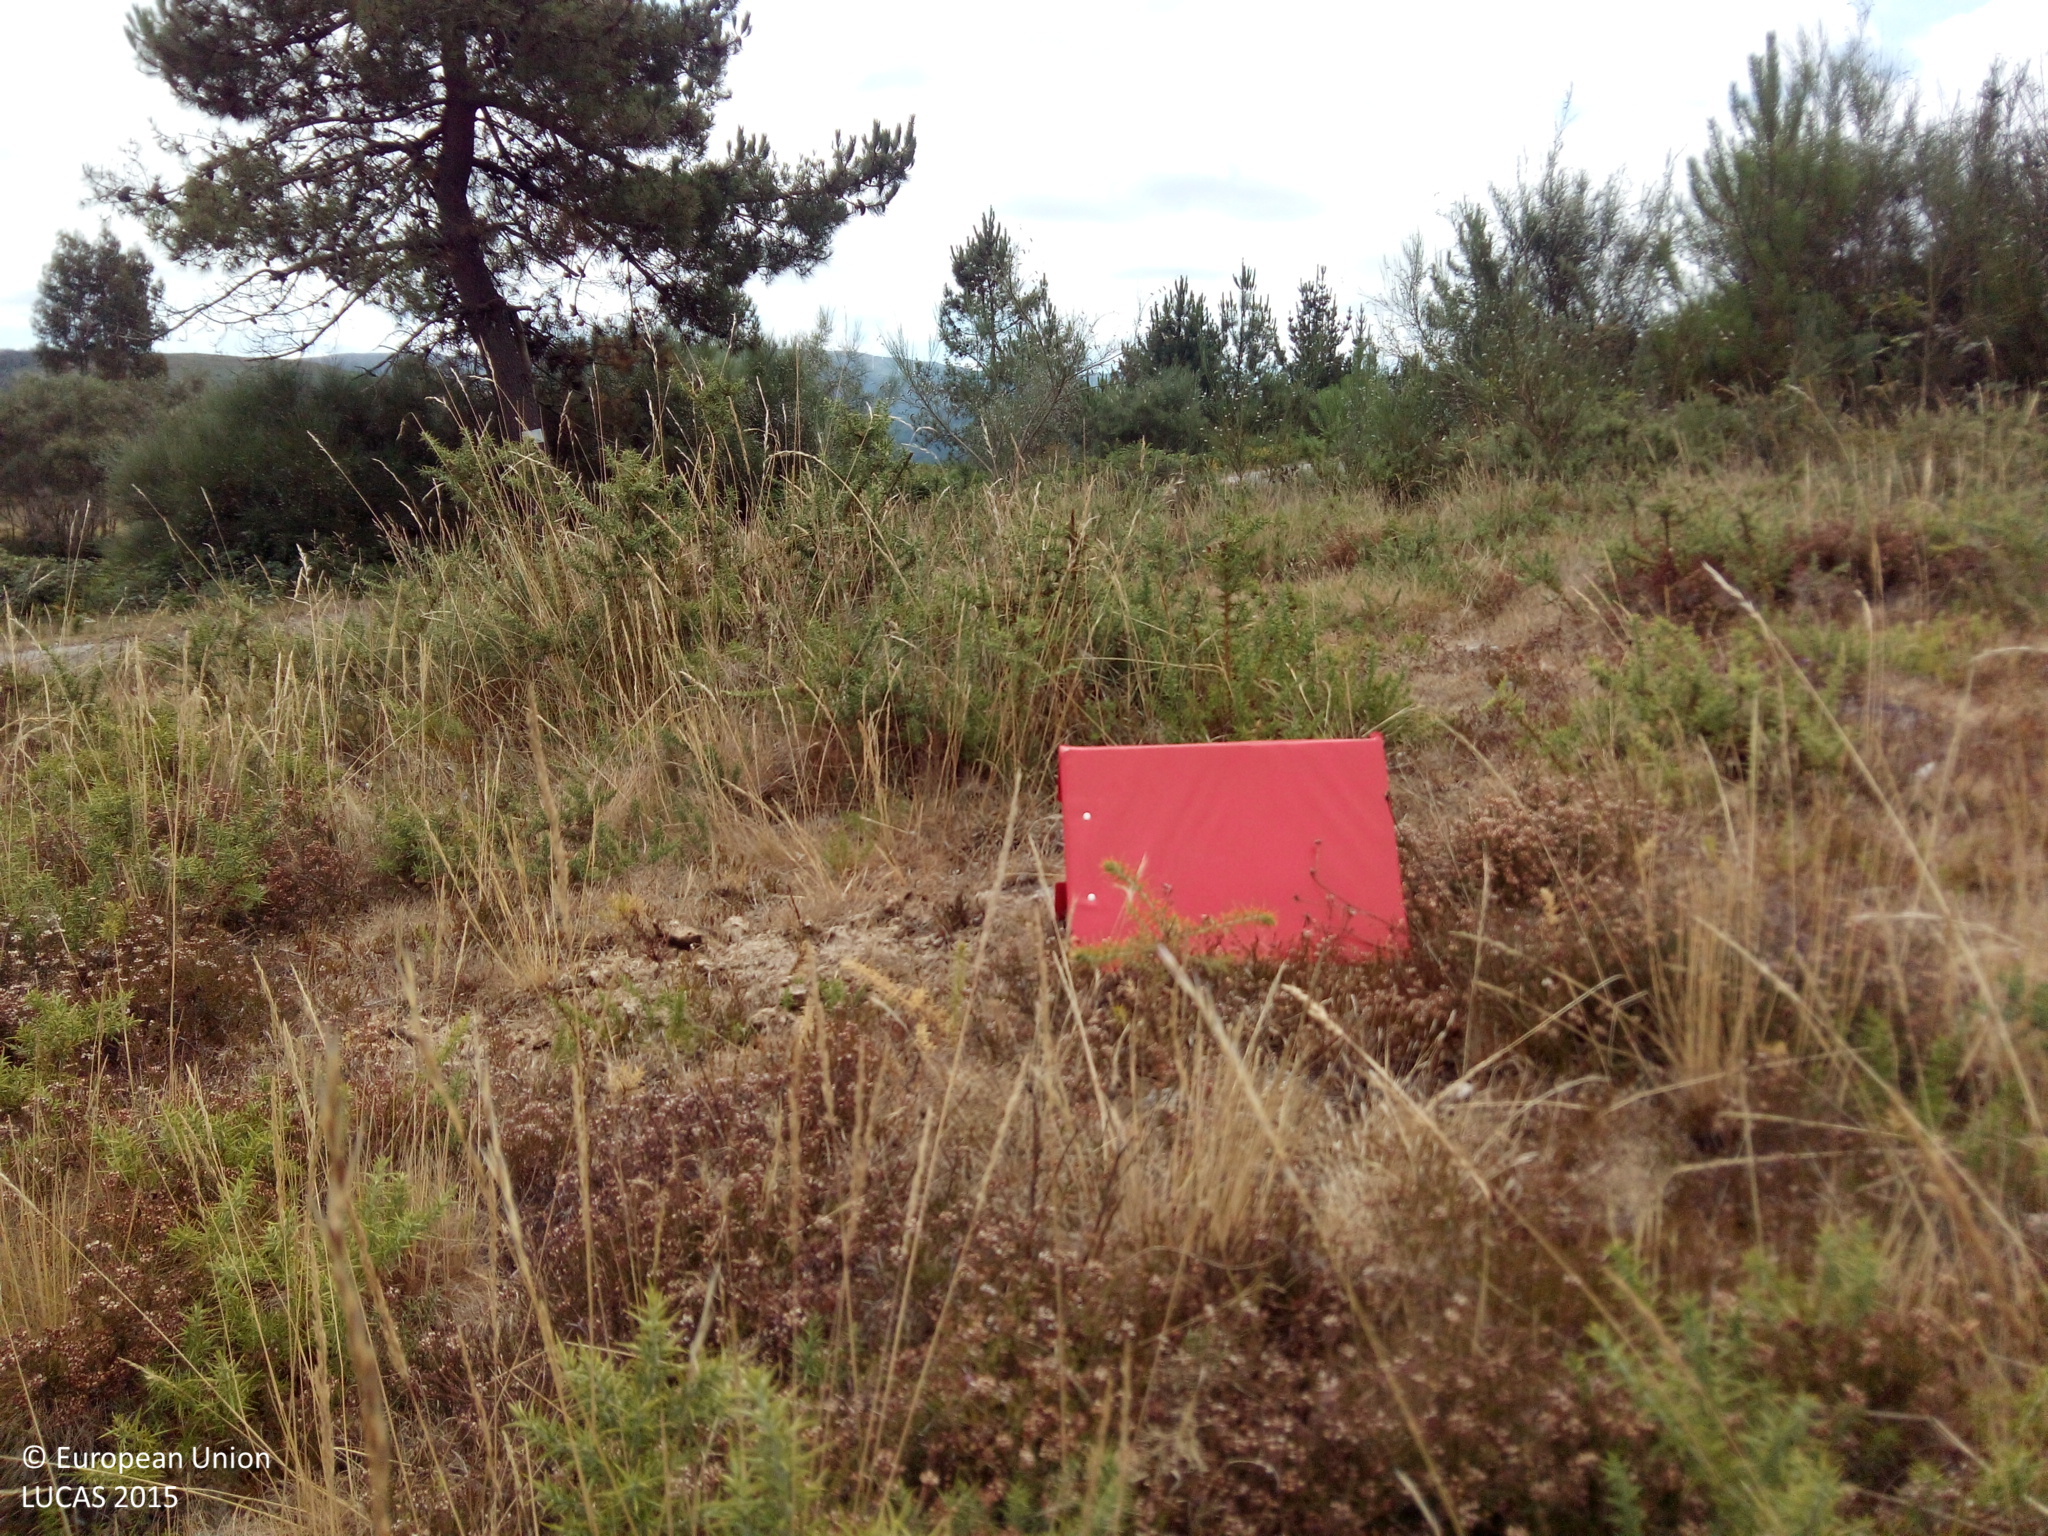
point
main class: Shrubland
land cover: Shrubland without tree cover
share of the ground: > 75 %
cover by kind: shrubs 100 %
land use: Abandoned areas
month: July
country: ES
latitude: 42.5491
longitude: -8.4496
